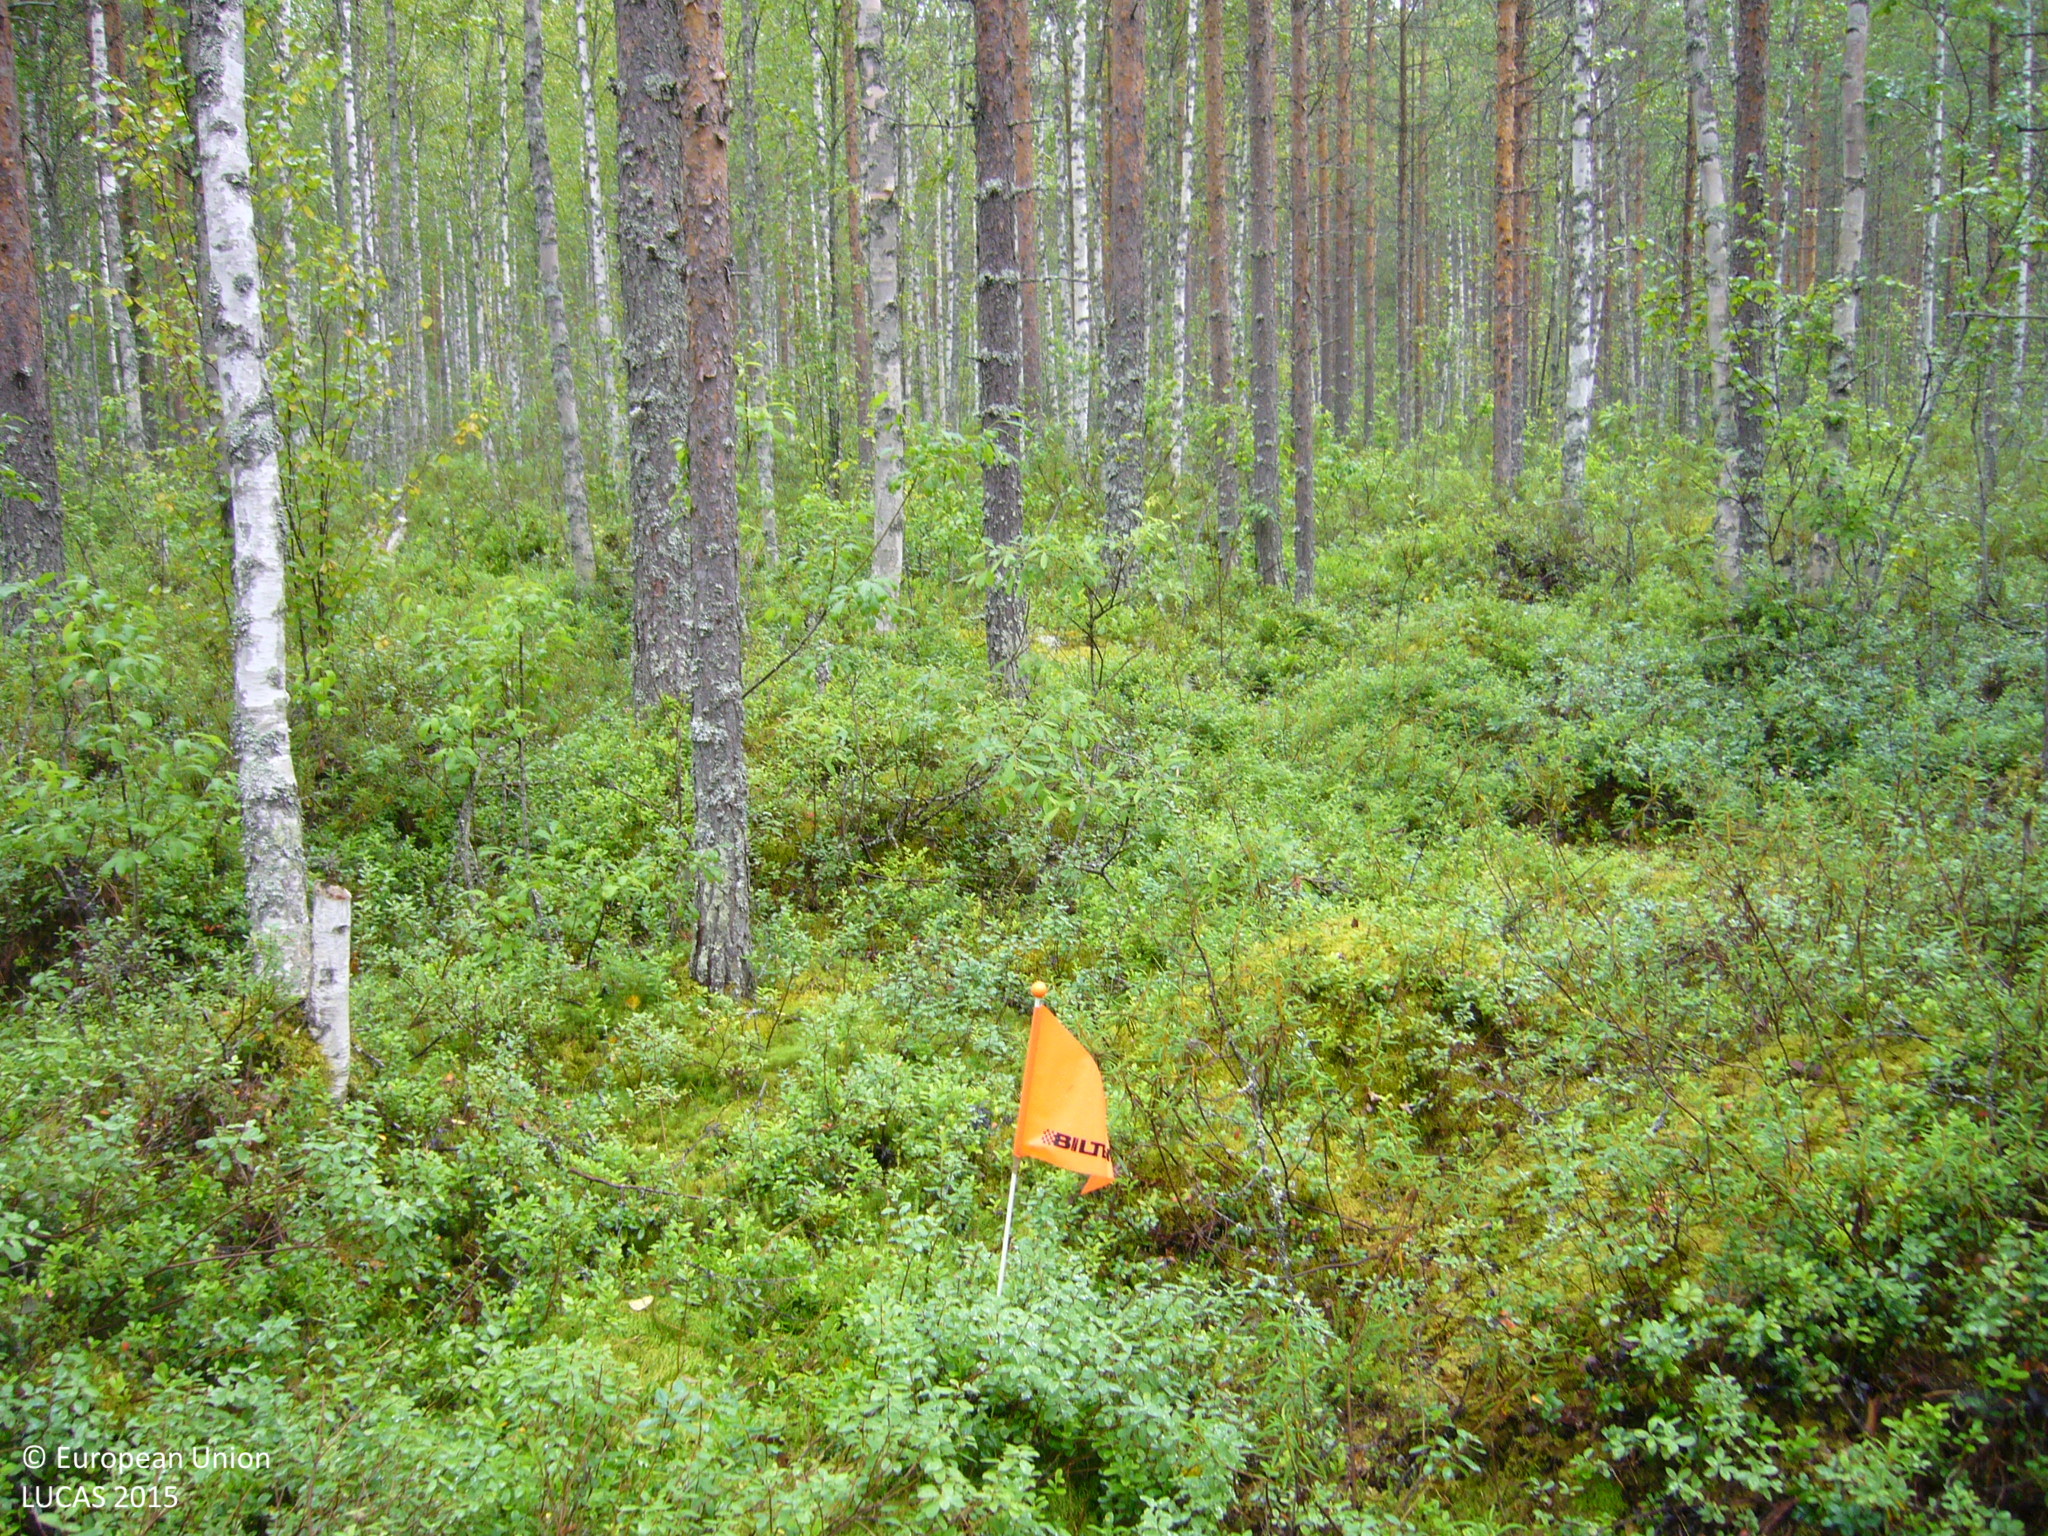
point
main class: Woodland
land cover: Pine dominated mixed woodland
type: boreal forest
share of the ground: 50 - 75 %
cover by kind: coniferous forest trees 40 %, broadleaved forest trees 30 %, shrubs 30 %
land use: Forestry
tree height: > 5 m
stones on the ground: 25 - 50 %
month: July
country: FI
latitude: 64.1668
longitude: 26.2164
